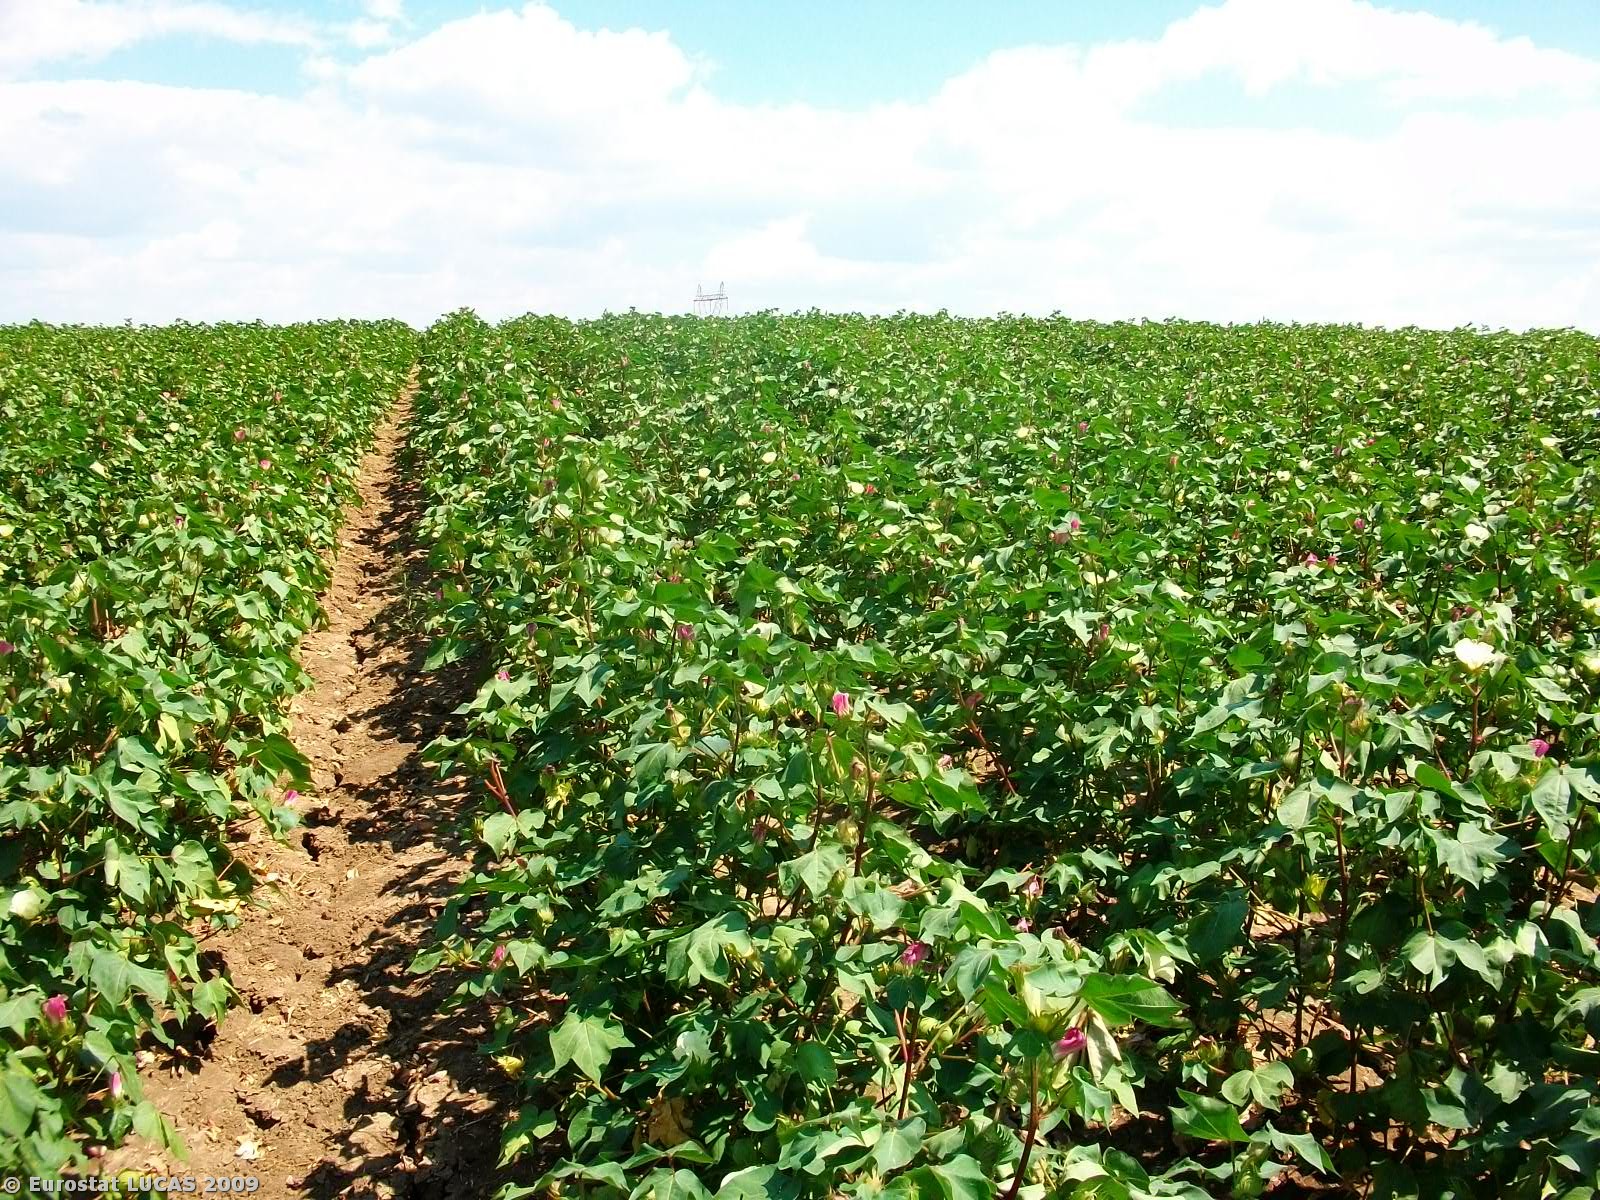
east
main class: Cropland
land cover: Cotton
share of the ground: 50 - 75 %
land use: Agriculture (excluding fallow land and kitchen gardens)
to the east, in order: Cotton; Common wheat; Sunflower; Electric lines; Sunflower; Common wheat
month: August
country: GR
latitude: 41.4824
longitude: 26.4488
